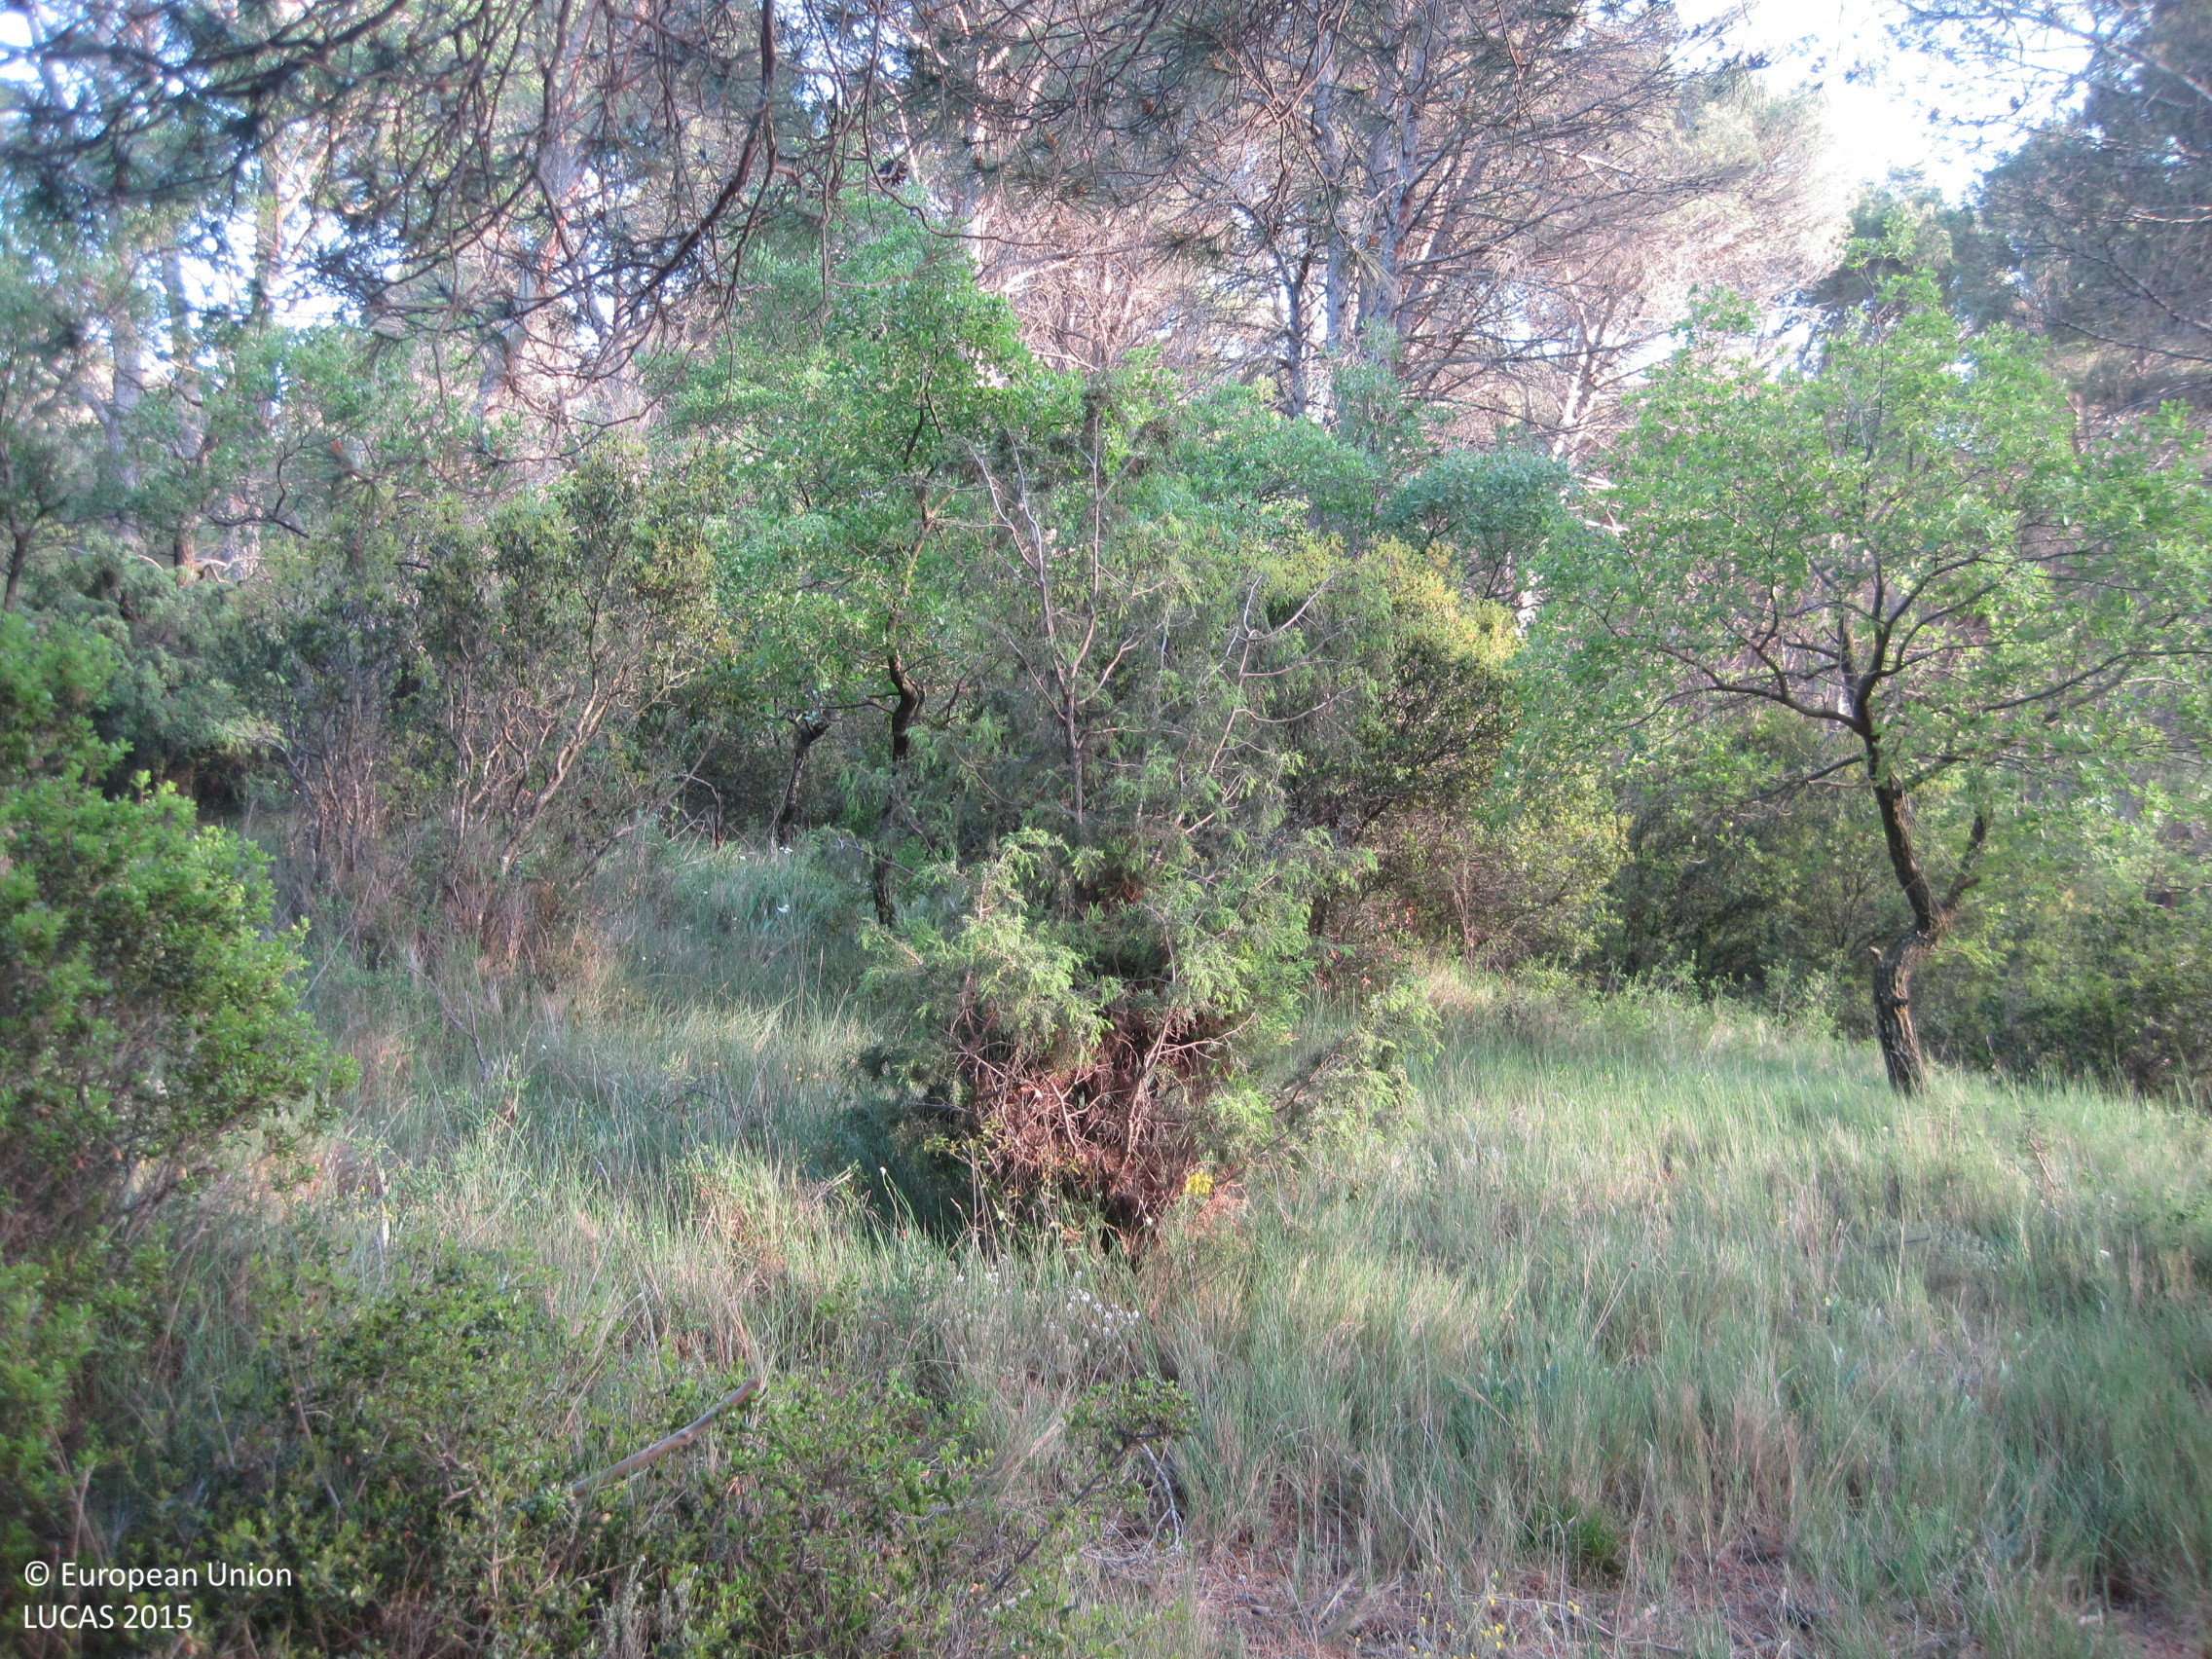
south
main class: Woodland
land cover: Pine dominated coniferous woodland
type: coniferous forest of the mediterranean region
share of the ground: > 75 %
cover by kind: coniferous forest trees 85 %, herbaceous plants 15 %
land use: Forestry
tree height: > 5 m
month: May
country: ES
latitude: 42.6082
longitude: -1.7279
